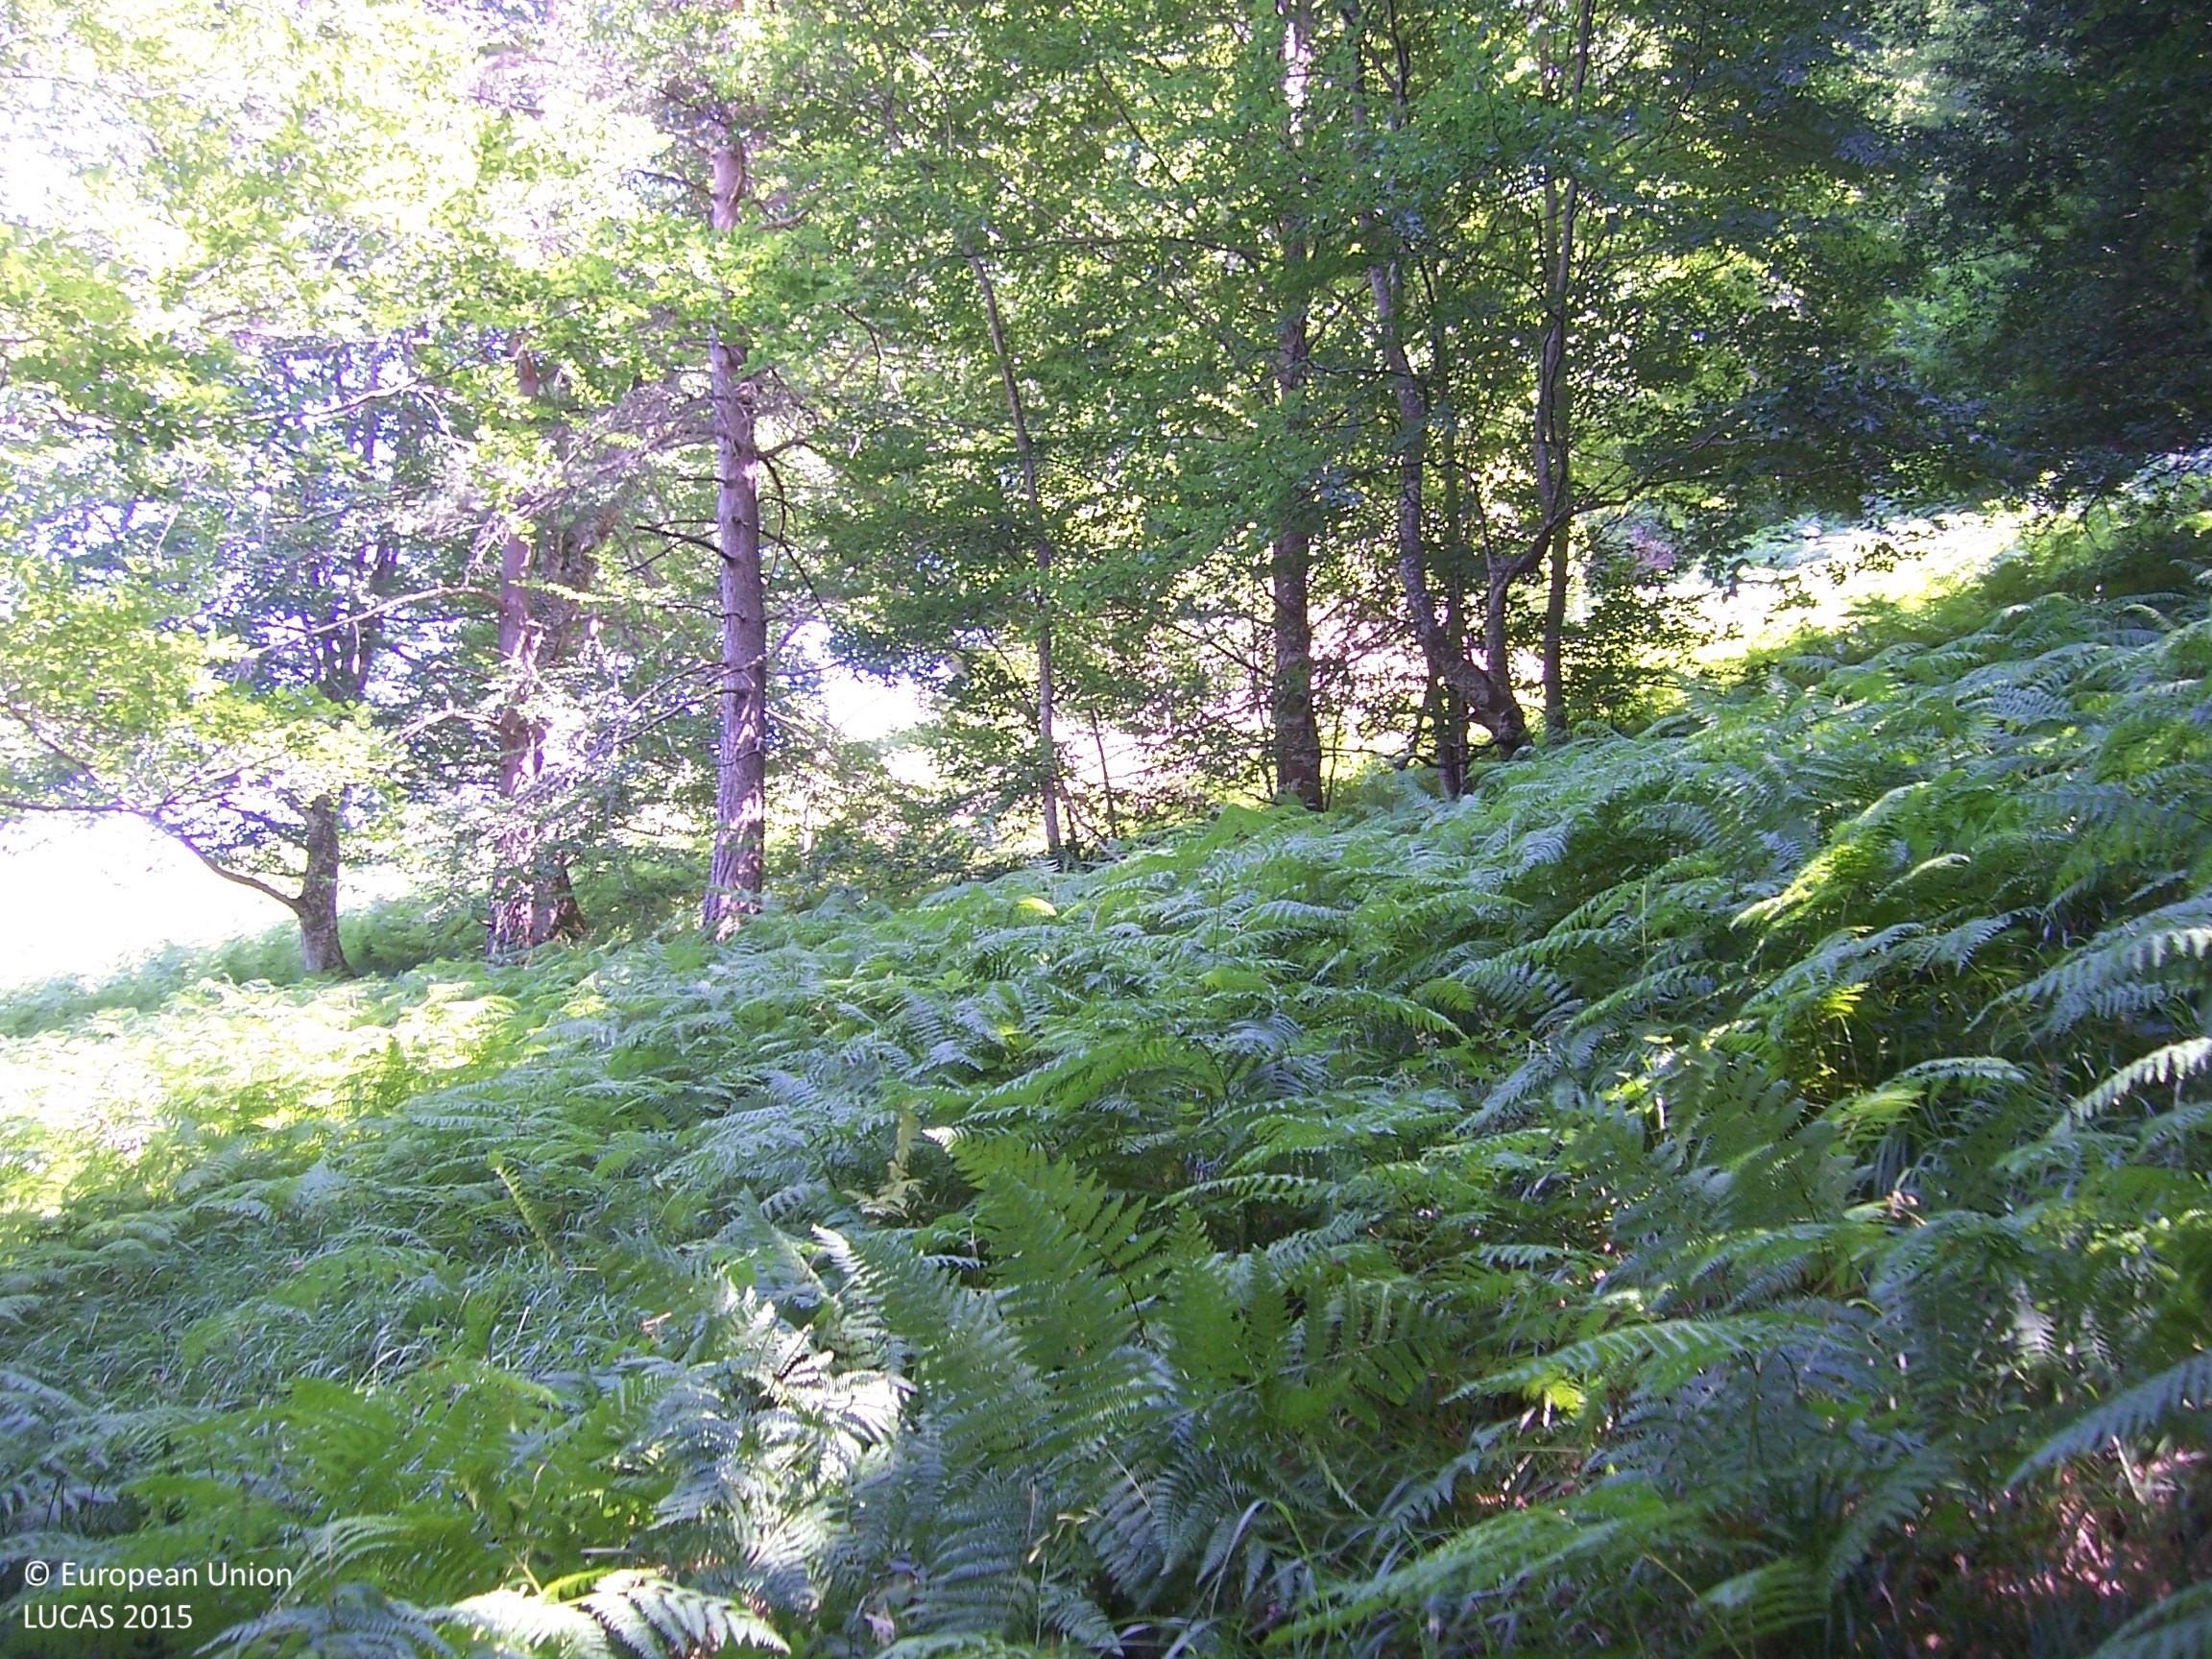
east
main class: Woodland
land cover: Broadleaved woodland
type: mountainous beech forest
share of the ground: > 75 %
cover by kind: broadleaved forest trees 100 %
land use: Forestry
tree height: > 5 m
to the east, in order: Broadleaved woodland; Grassland with sparse tree/shrub cover; Grassland without tree/shrub cover; Fences; Inland fresh water bodies; Fences; Pine dominated coniferous woodland
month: July
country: ES
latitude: 42.9236
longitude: -1.1968
